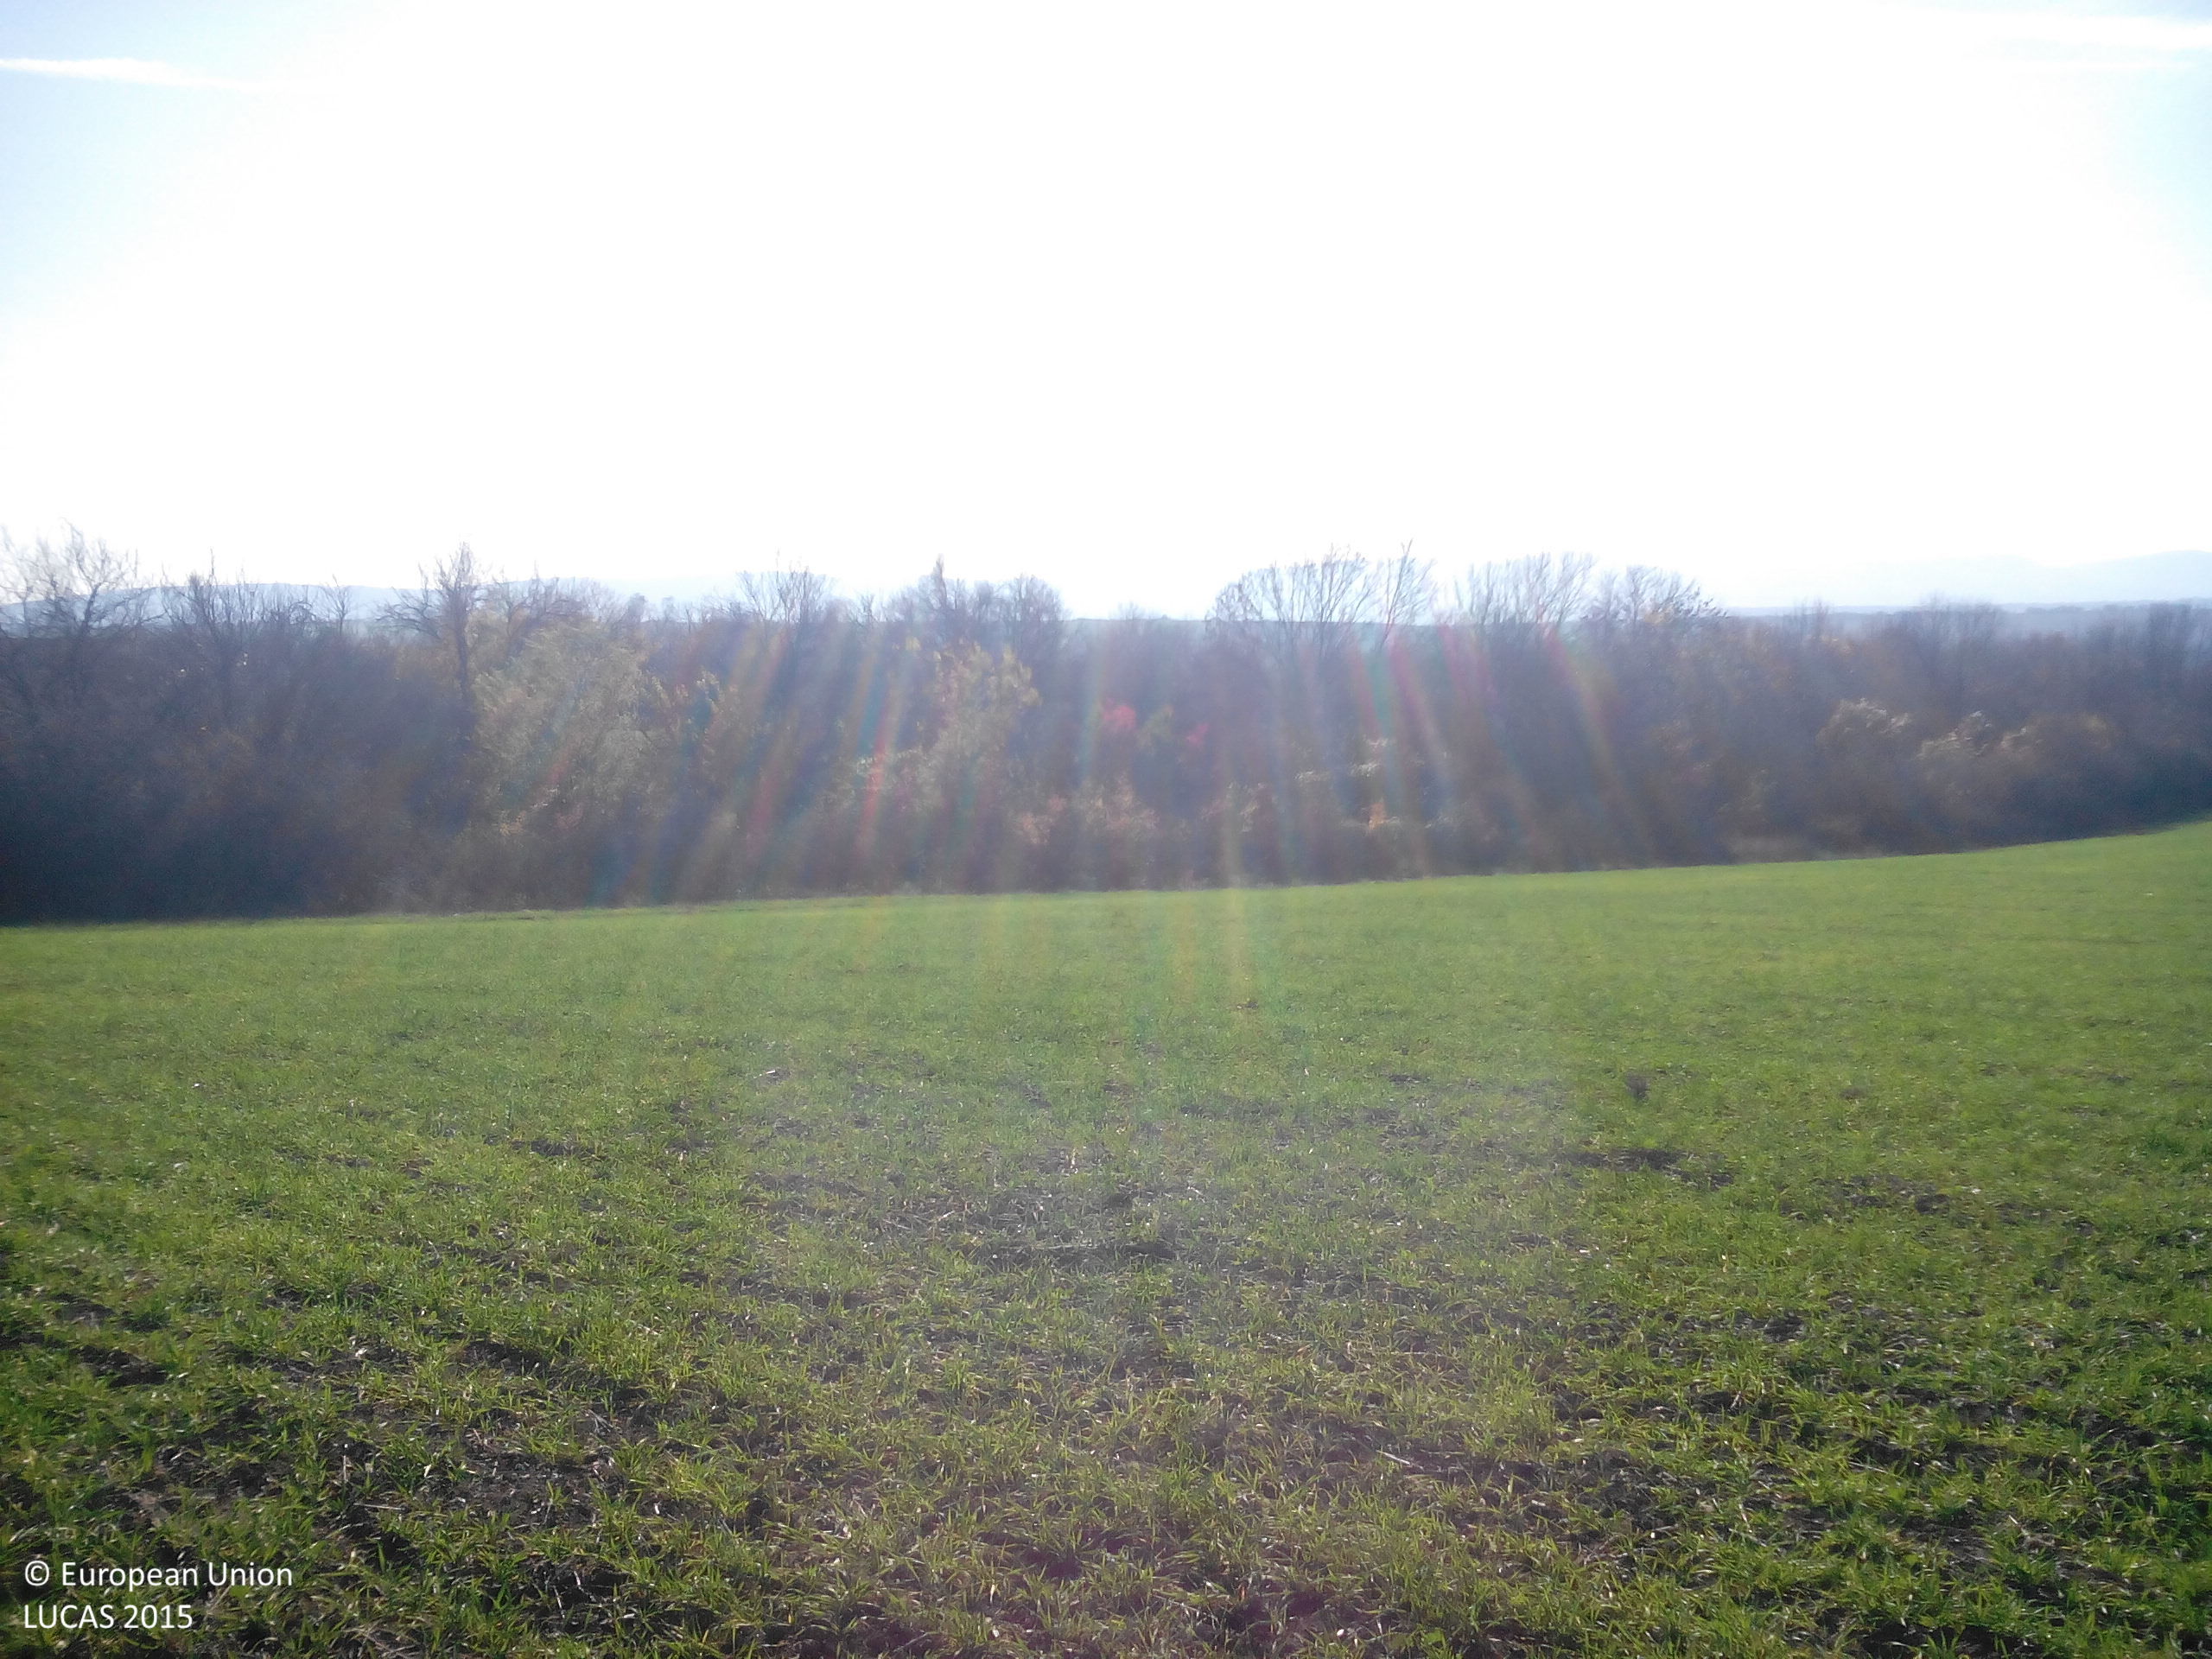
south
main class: Cropland
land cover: Common wheat
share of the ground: 50 - 75 %
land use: Agriculture (excluding fallow land and kitchen gardens)
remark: Harvested field
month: November
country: BG
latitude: 43.3111
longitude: 23.8195
